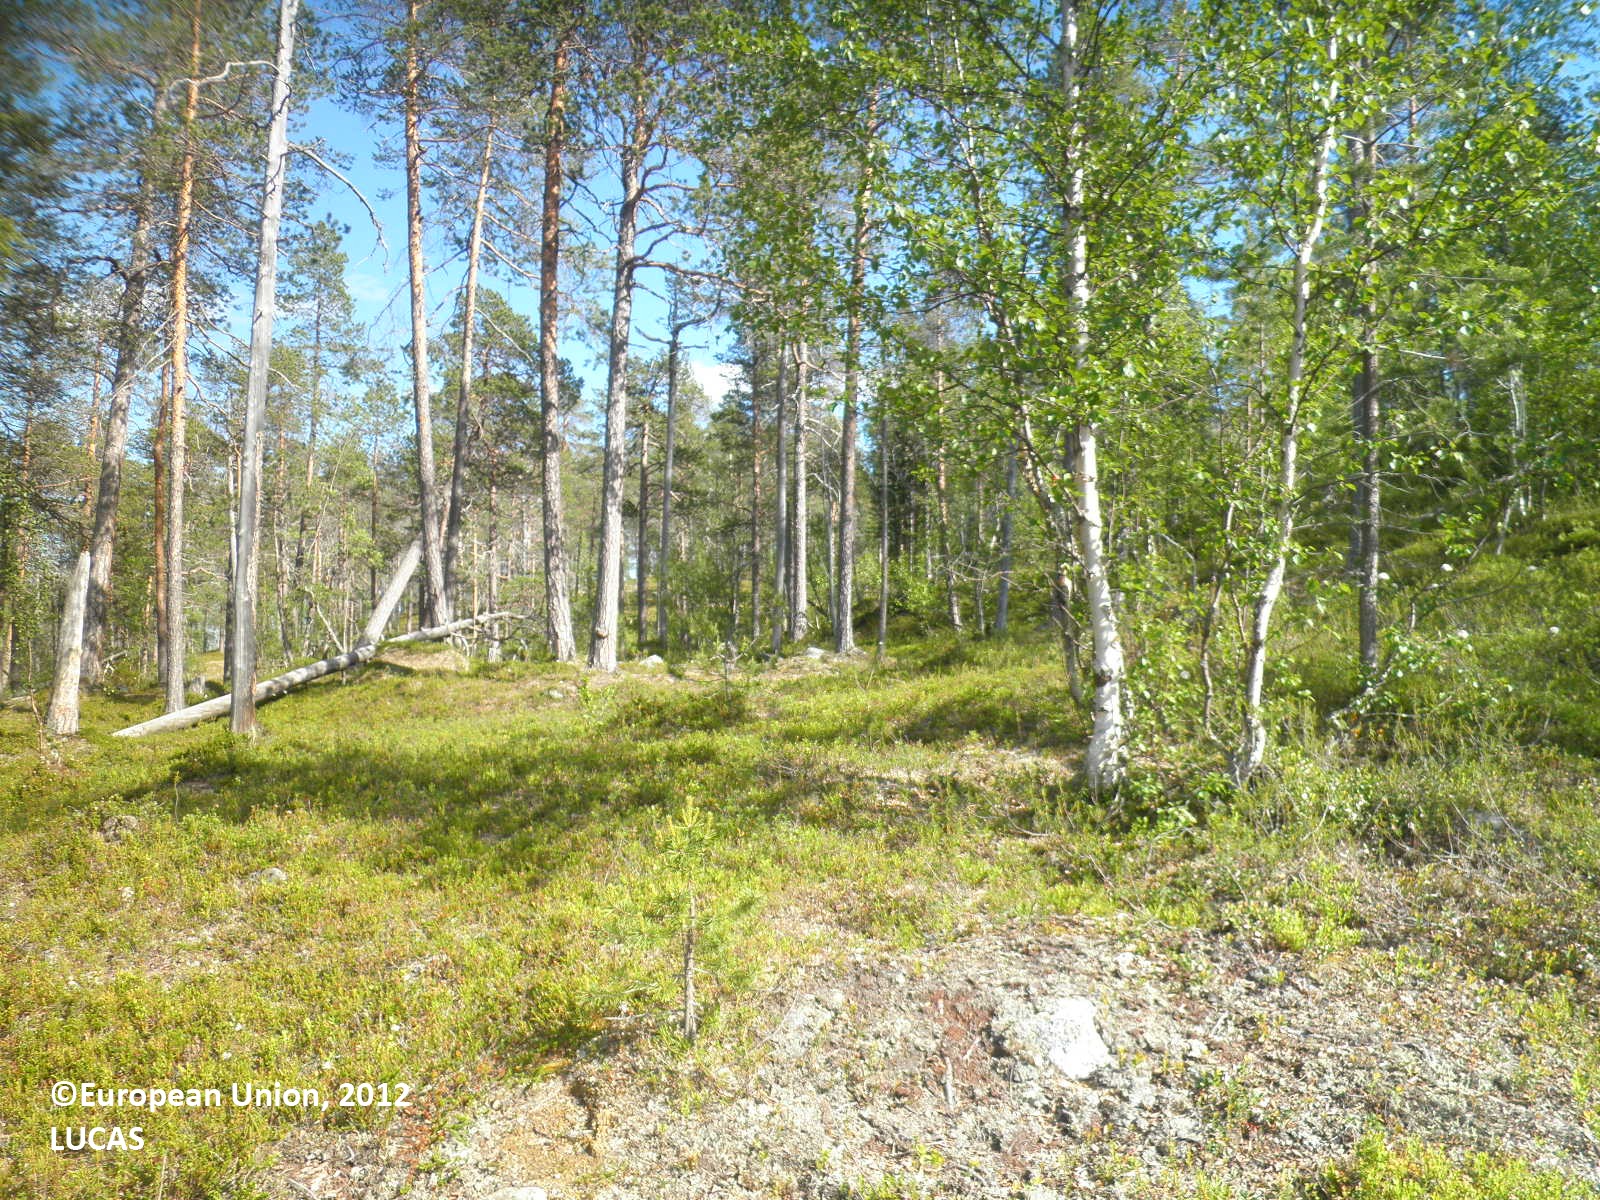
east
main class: Woodland
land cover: Pine dominated mixed woodland
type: boreal forest
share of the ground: 50 - 75 %
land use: Forestry
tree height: > 5 m
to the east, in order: Pine dominated mixed woodland; Rivers and streams; Pine dominated coniferous woodland; Pine dominated mixed woodland
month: July
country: FI
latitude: 68.8932
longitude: 27.0051
